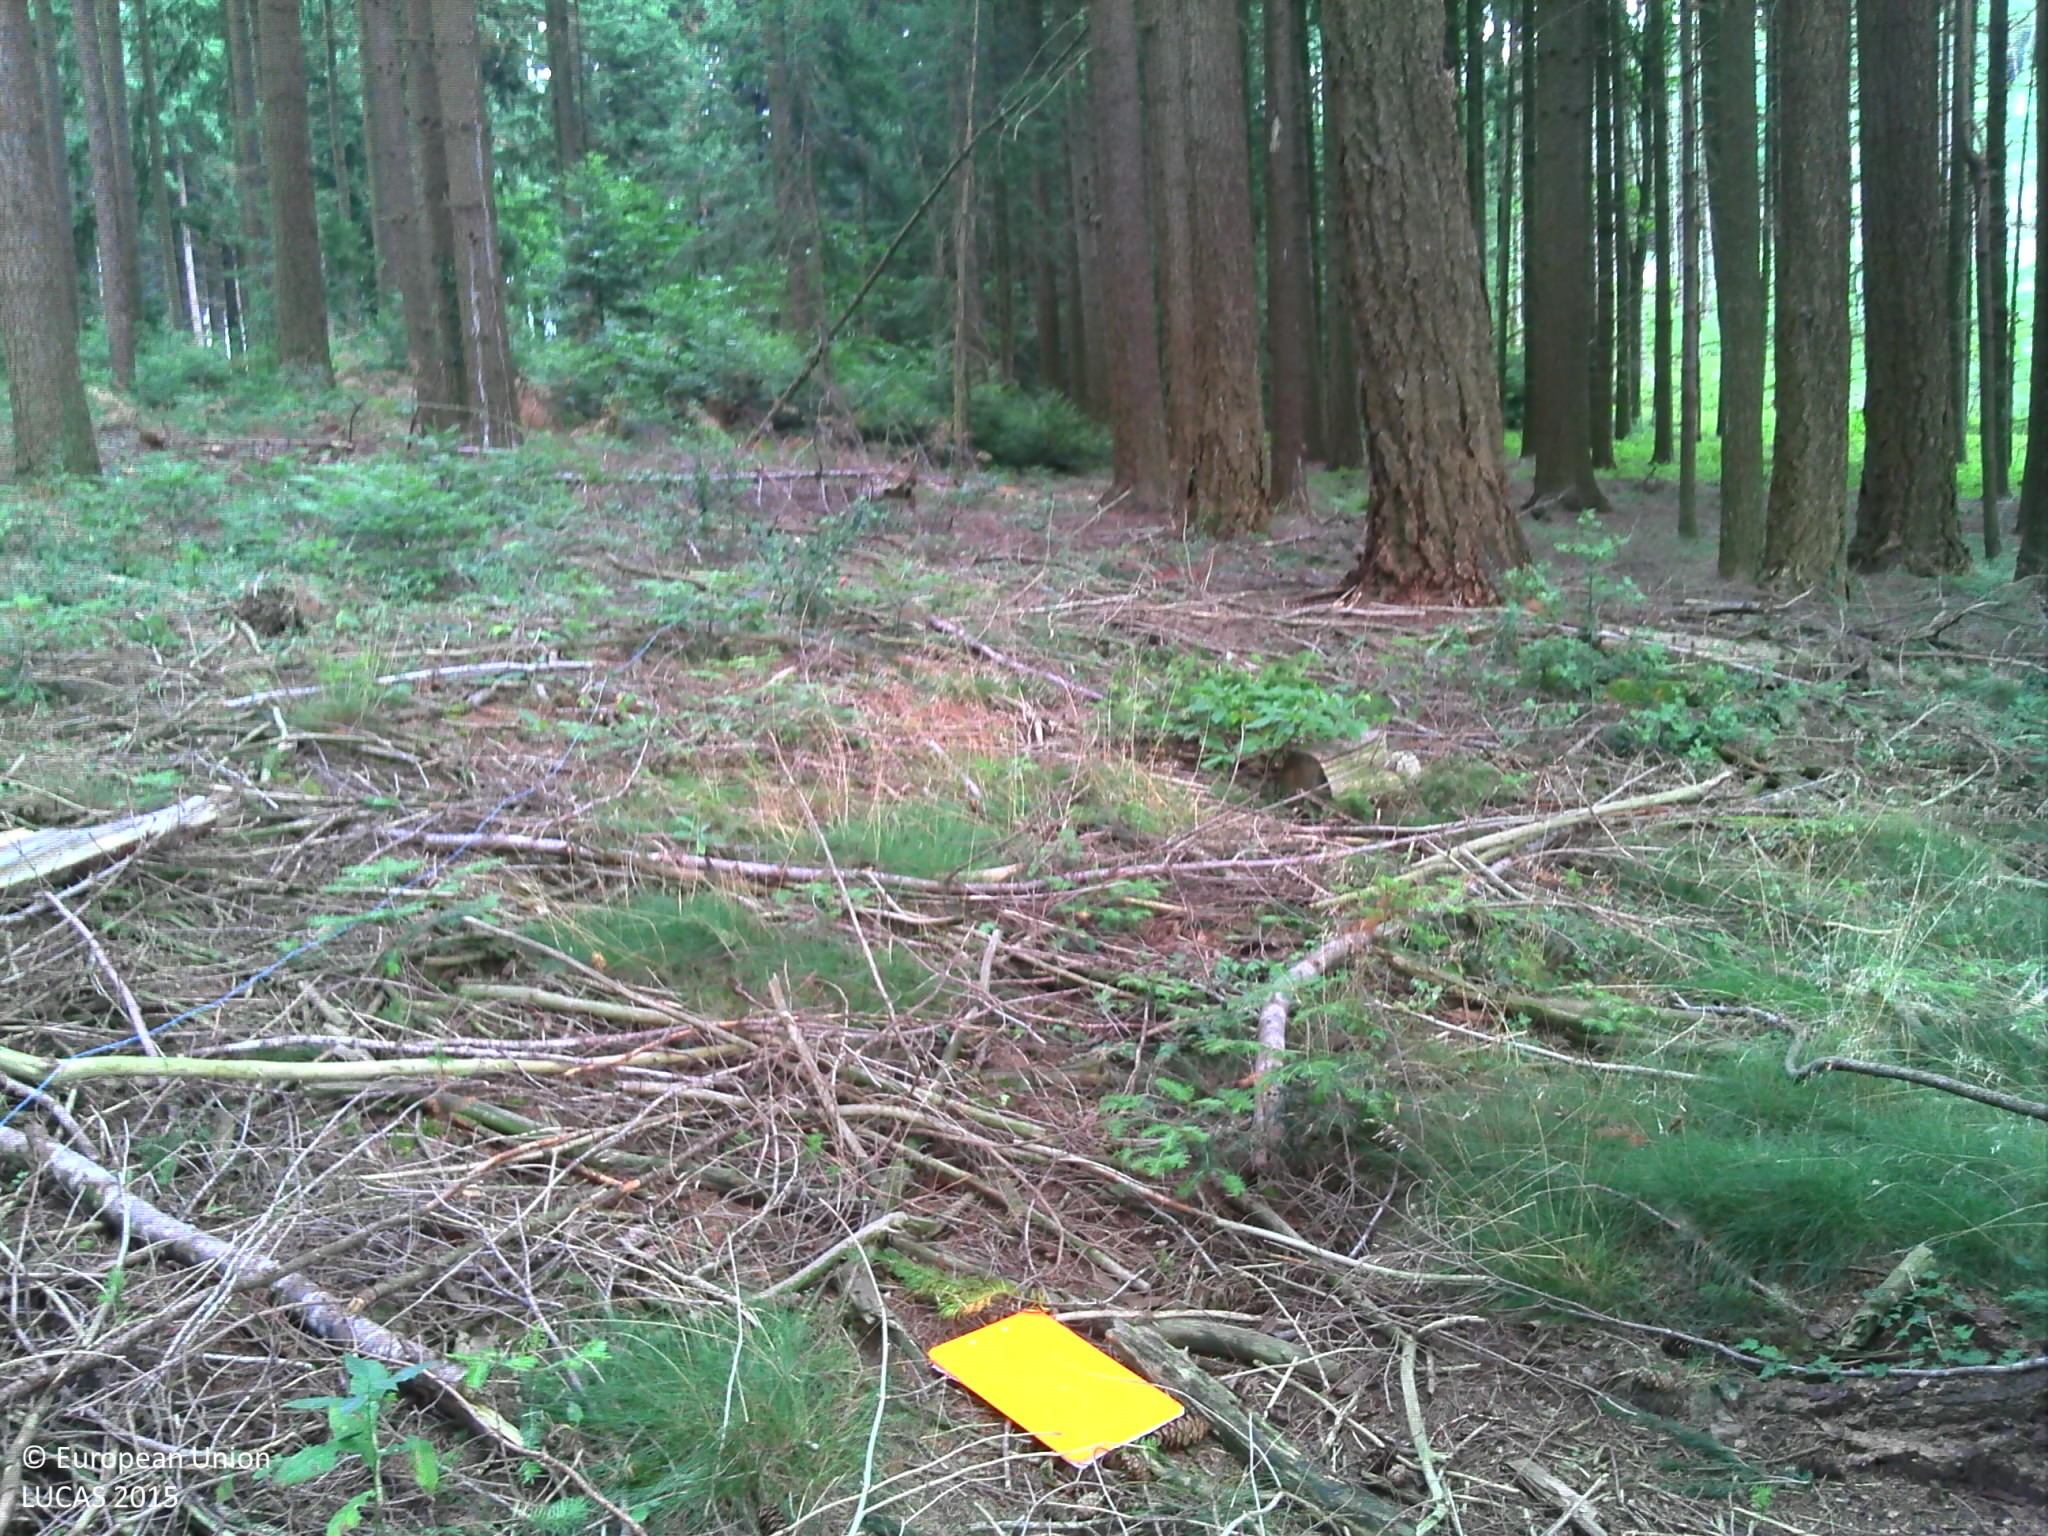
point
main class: Woodland
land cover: Spruce dominated coniferous woodland
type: exotic forest
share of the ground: > 75 %
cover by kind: coniferous forest trees 80 %, herbaceous plants 20 %
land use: Forestry
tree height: > 5 m
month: August
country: FR
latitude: 46.2606
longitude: 4.4362
